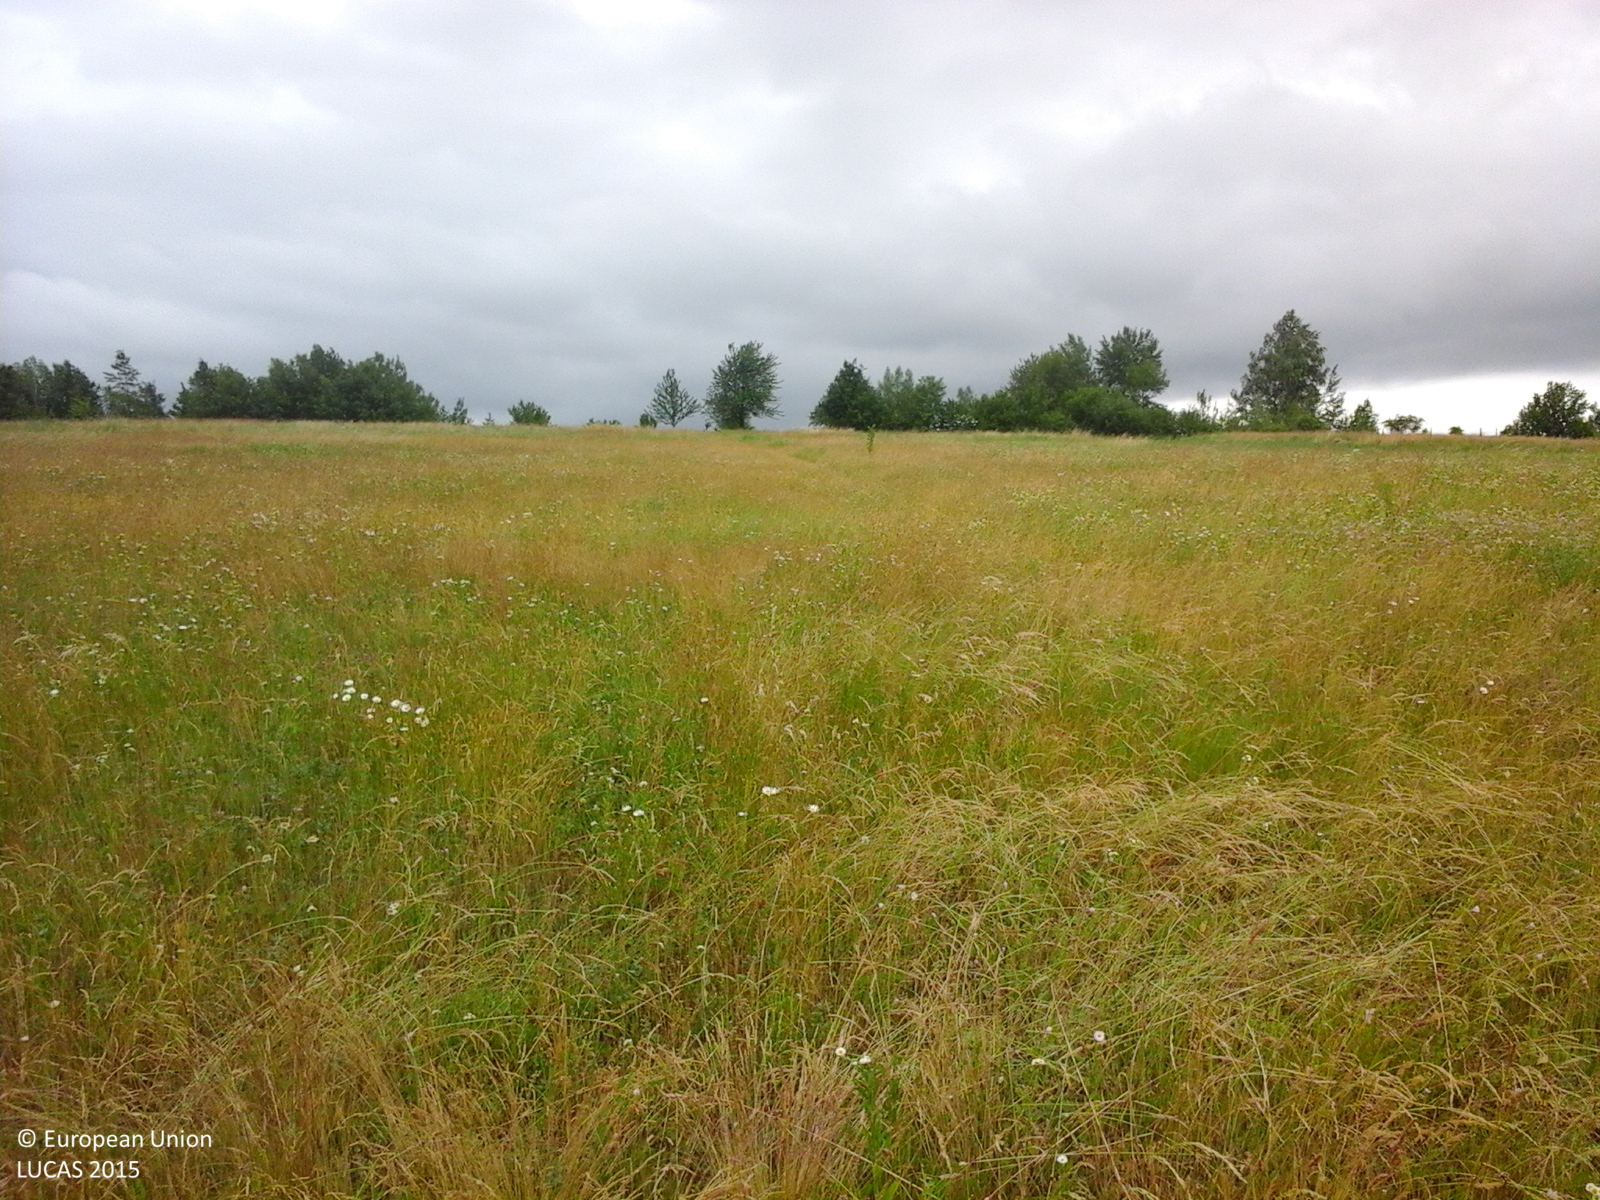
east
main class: Grassland
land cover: Grassland without tree/shrub cover
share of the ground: > 75 %
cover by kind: herbaceous plants 100 %
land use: Agriculture (excluding fallow land and kitchen gardens)
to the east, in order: Grassland without tree/shrub cover; Lucerne; Grassland without tree/shrub cover; Fences; Other fruit trees and berries; Fences; Grassland without tree/shrub cover; Abandoned hedges; Lucerne; Maize; Lucerne; Grassland without tree/shrub cover
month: June
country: RO
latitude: 47.1656
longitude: 26.2939
